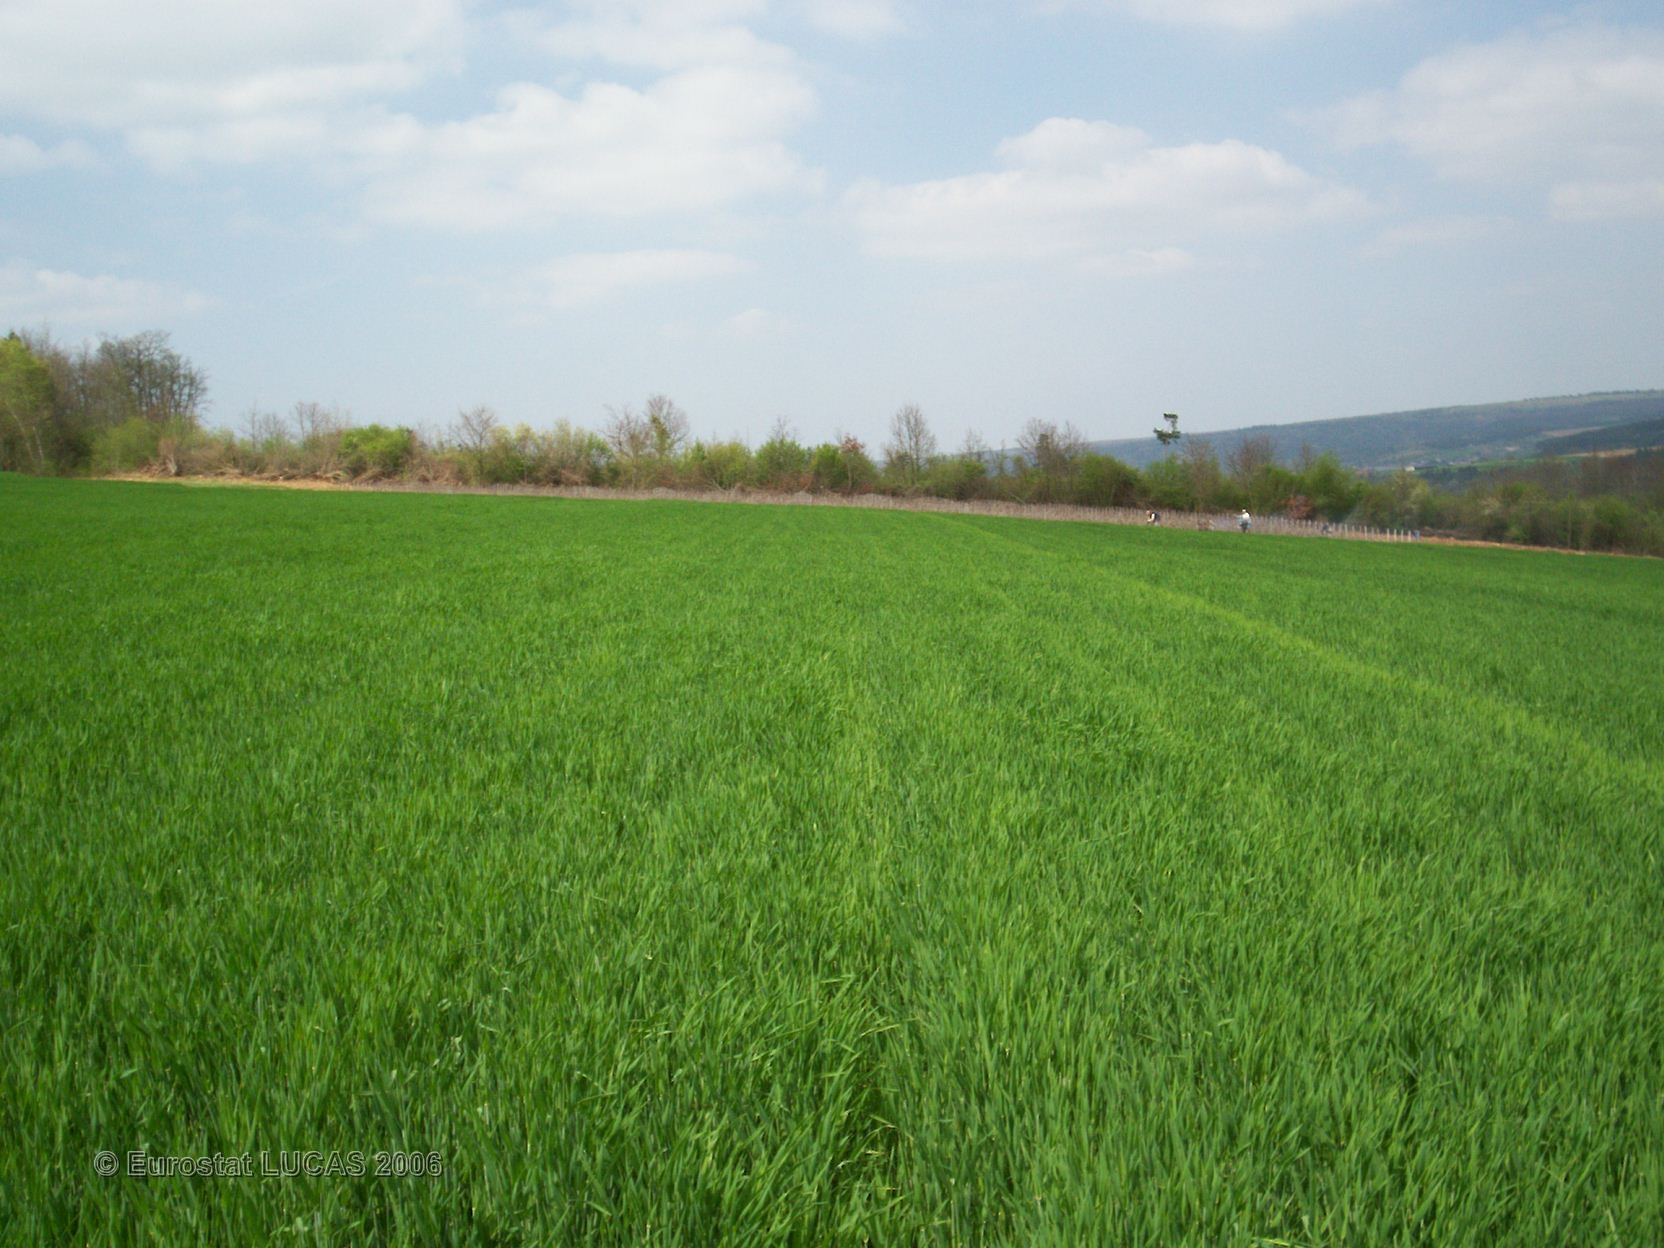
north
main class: Cropland
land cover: Barley
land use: Agriculture (excluding fallow land and kitchen gardens)
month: April
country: FR
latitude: 47.9418
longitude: 4.4959
